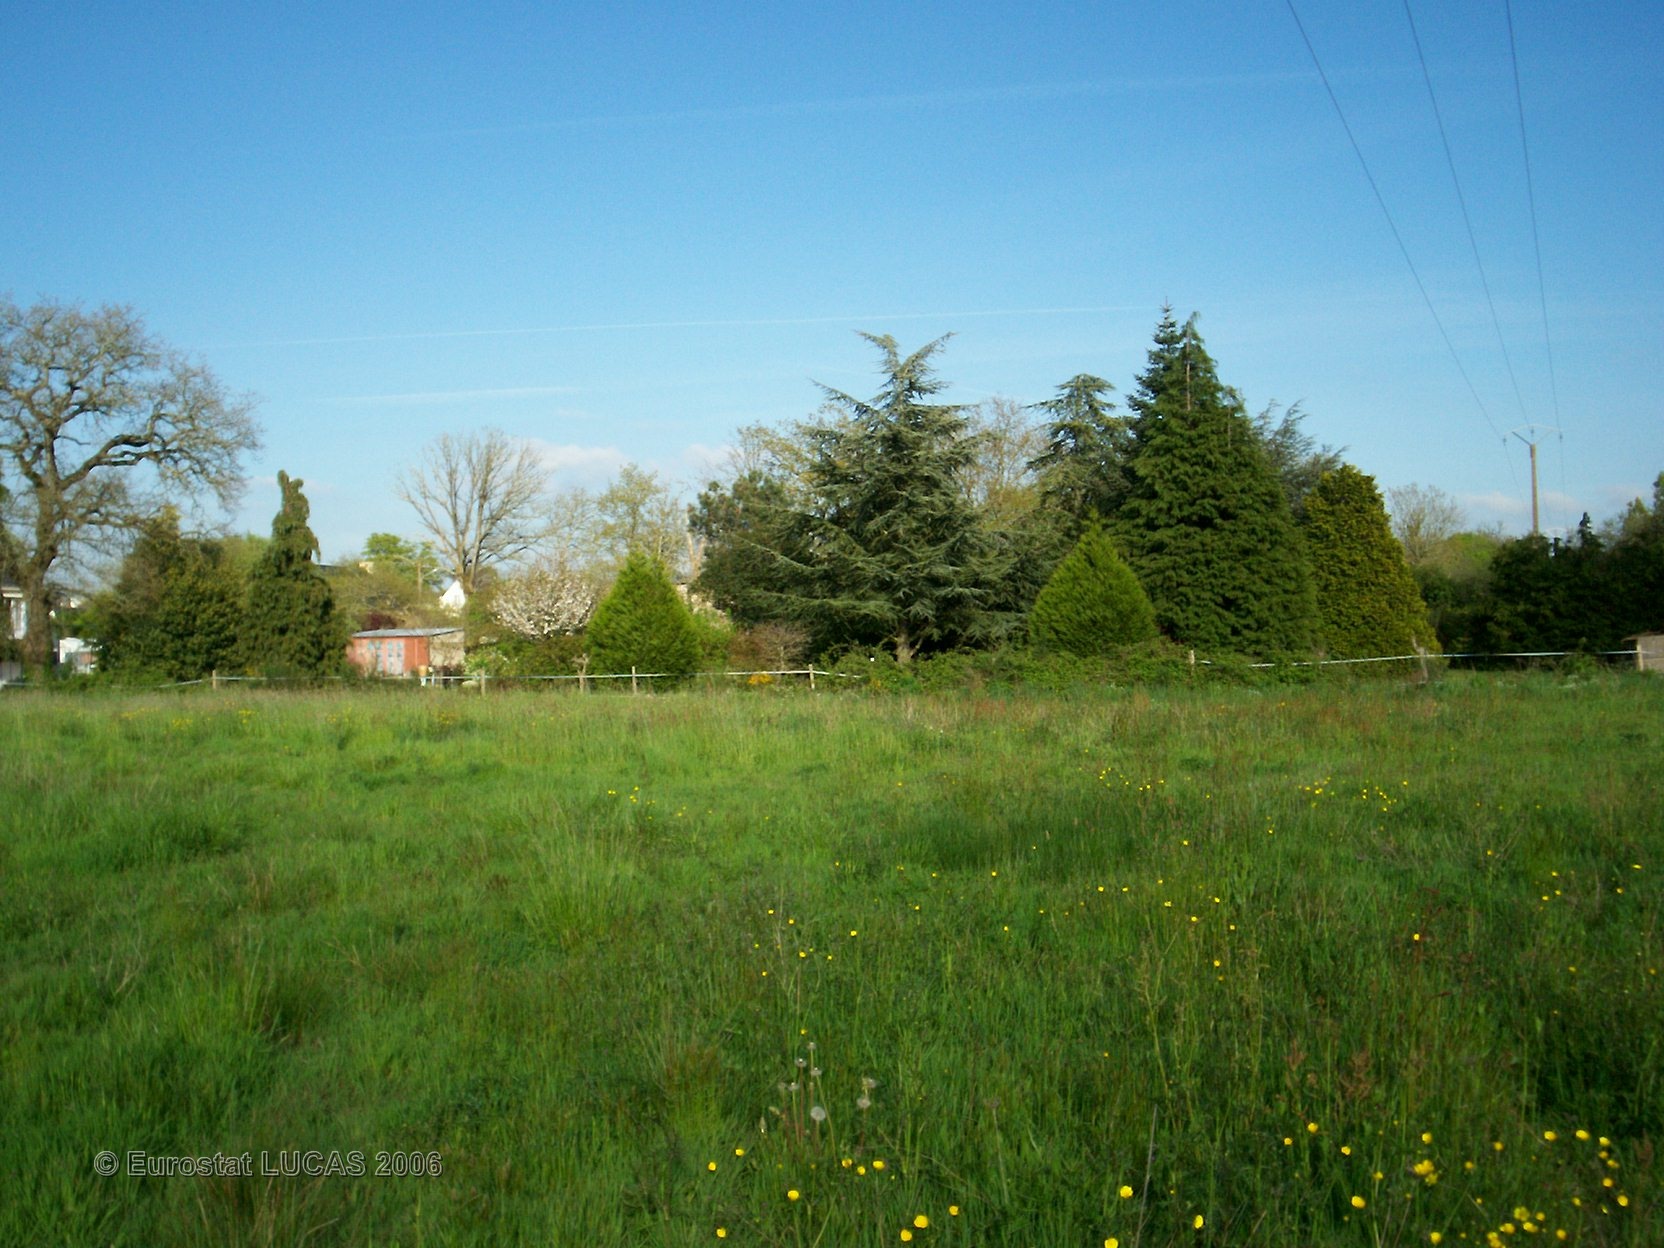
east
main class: Grassland
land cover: Grassland without tree/shrub cover
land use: Agriculture (excluding fallow land and kitchen gardens)
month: May
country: FR
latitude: 47.6061
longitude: -2.6029
